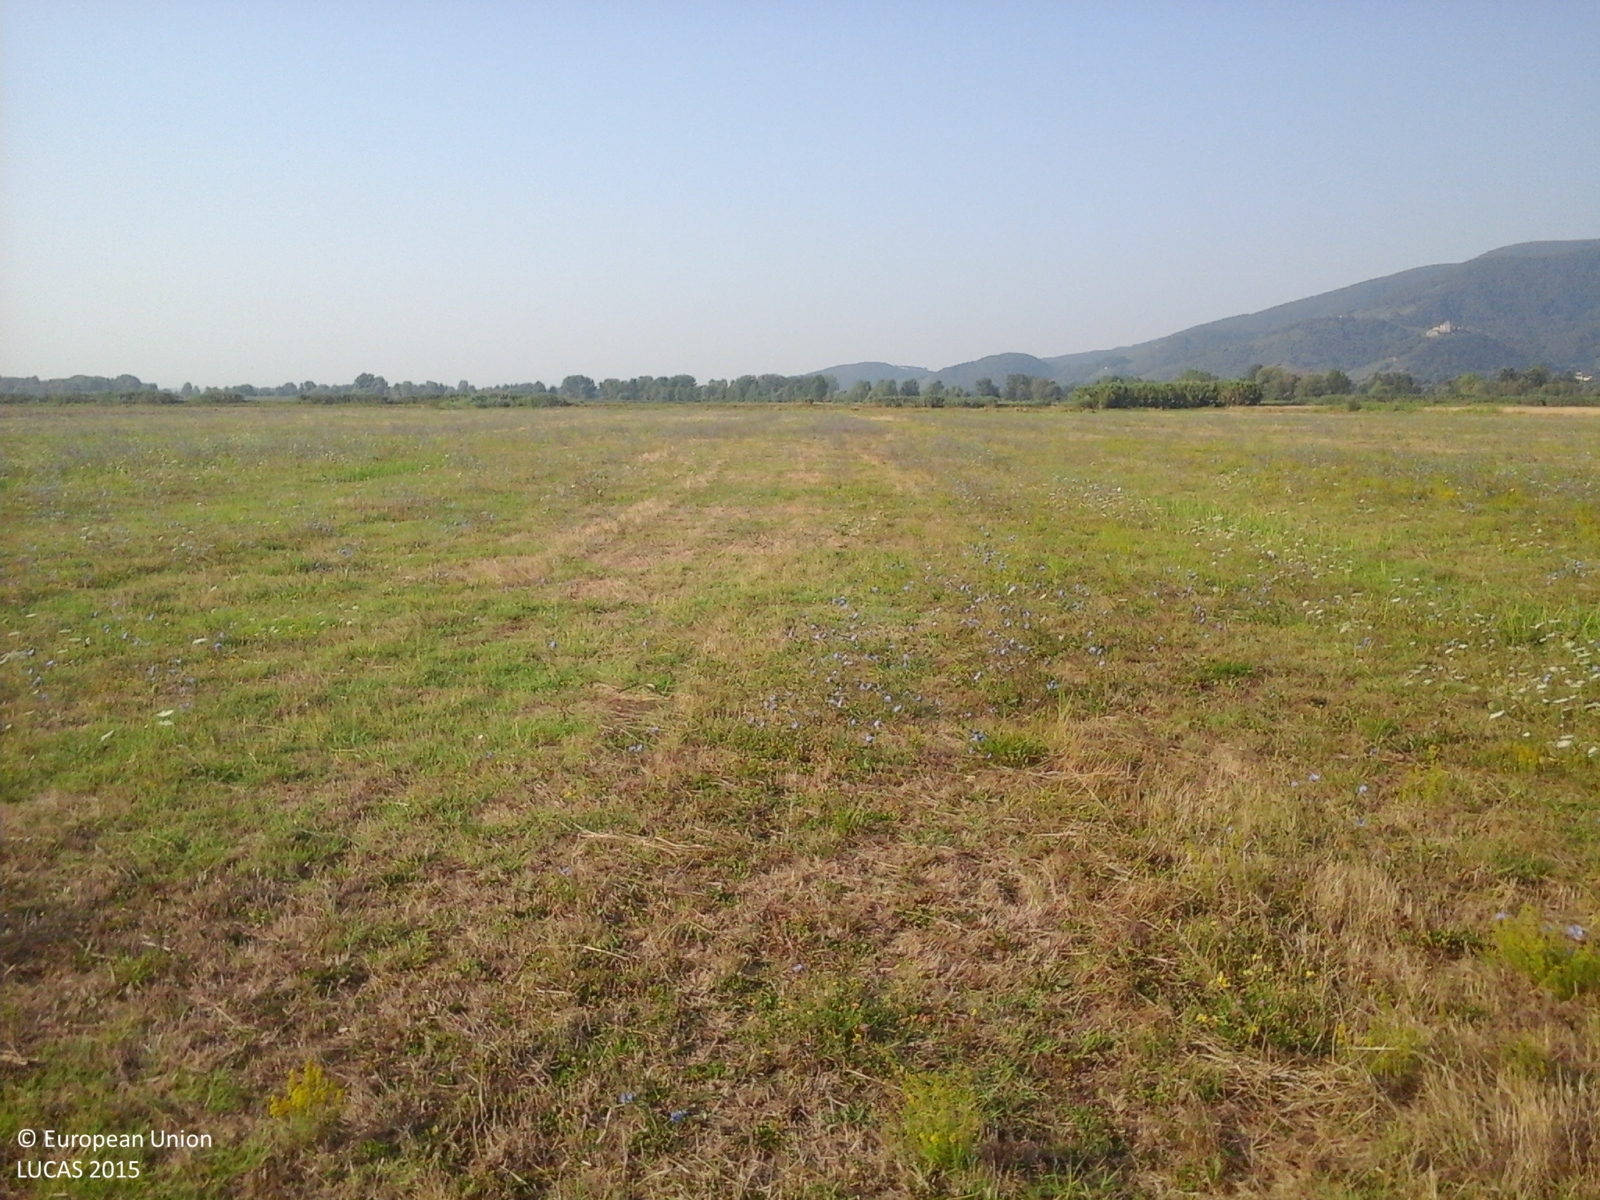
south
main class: Cropland
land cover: Temporary grasslands
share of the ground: > 75 %
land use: Agriculture (excluding fallow land and kitchen gardens)
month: August
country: IT
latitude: 43.7894
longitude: 10.6321
